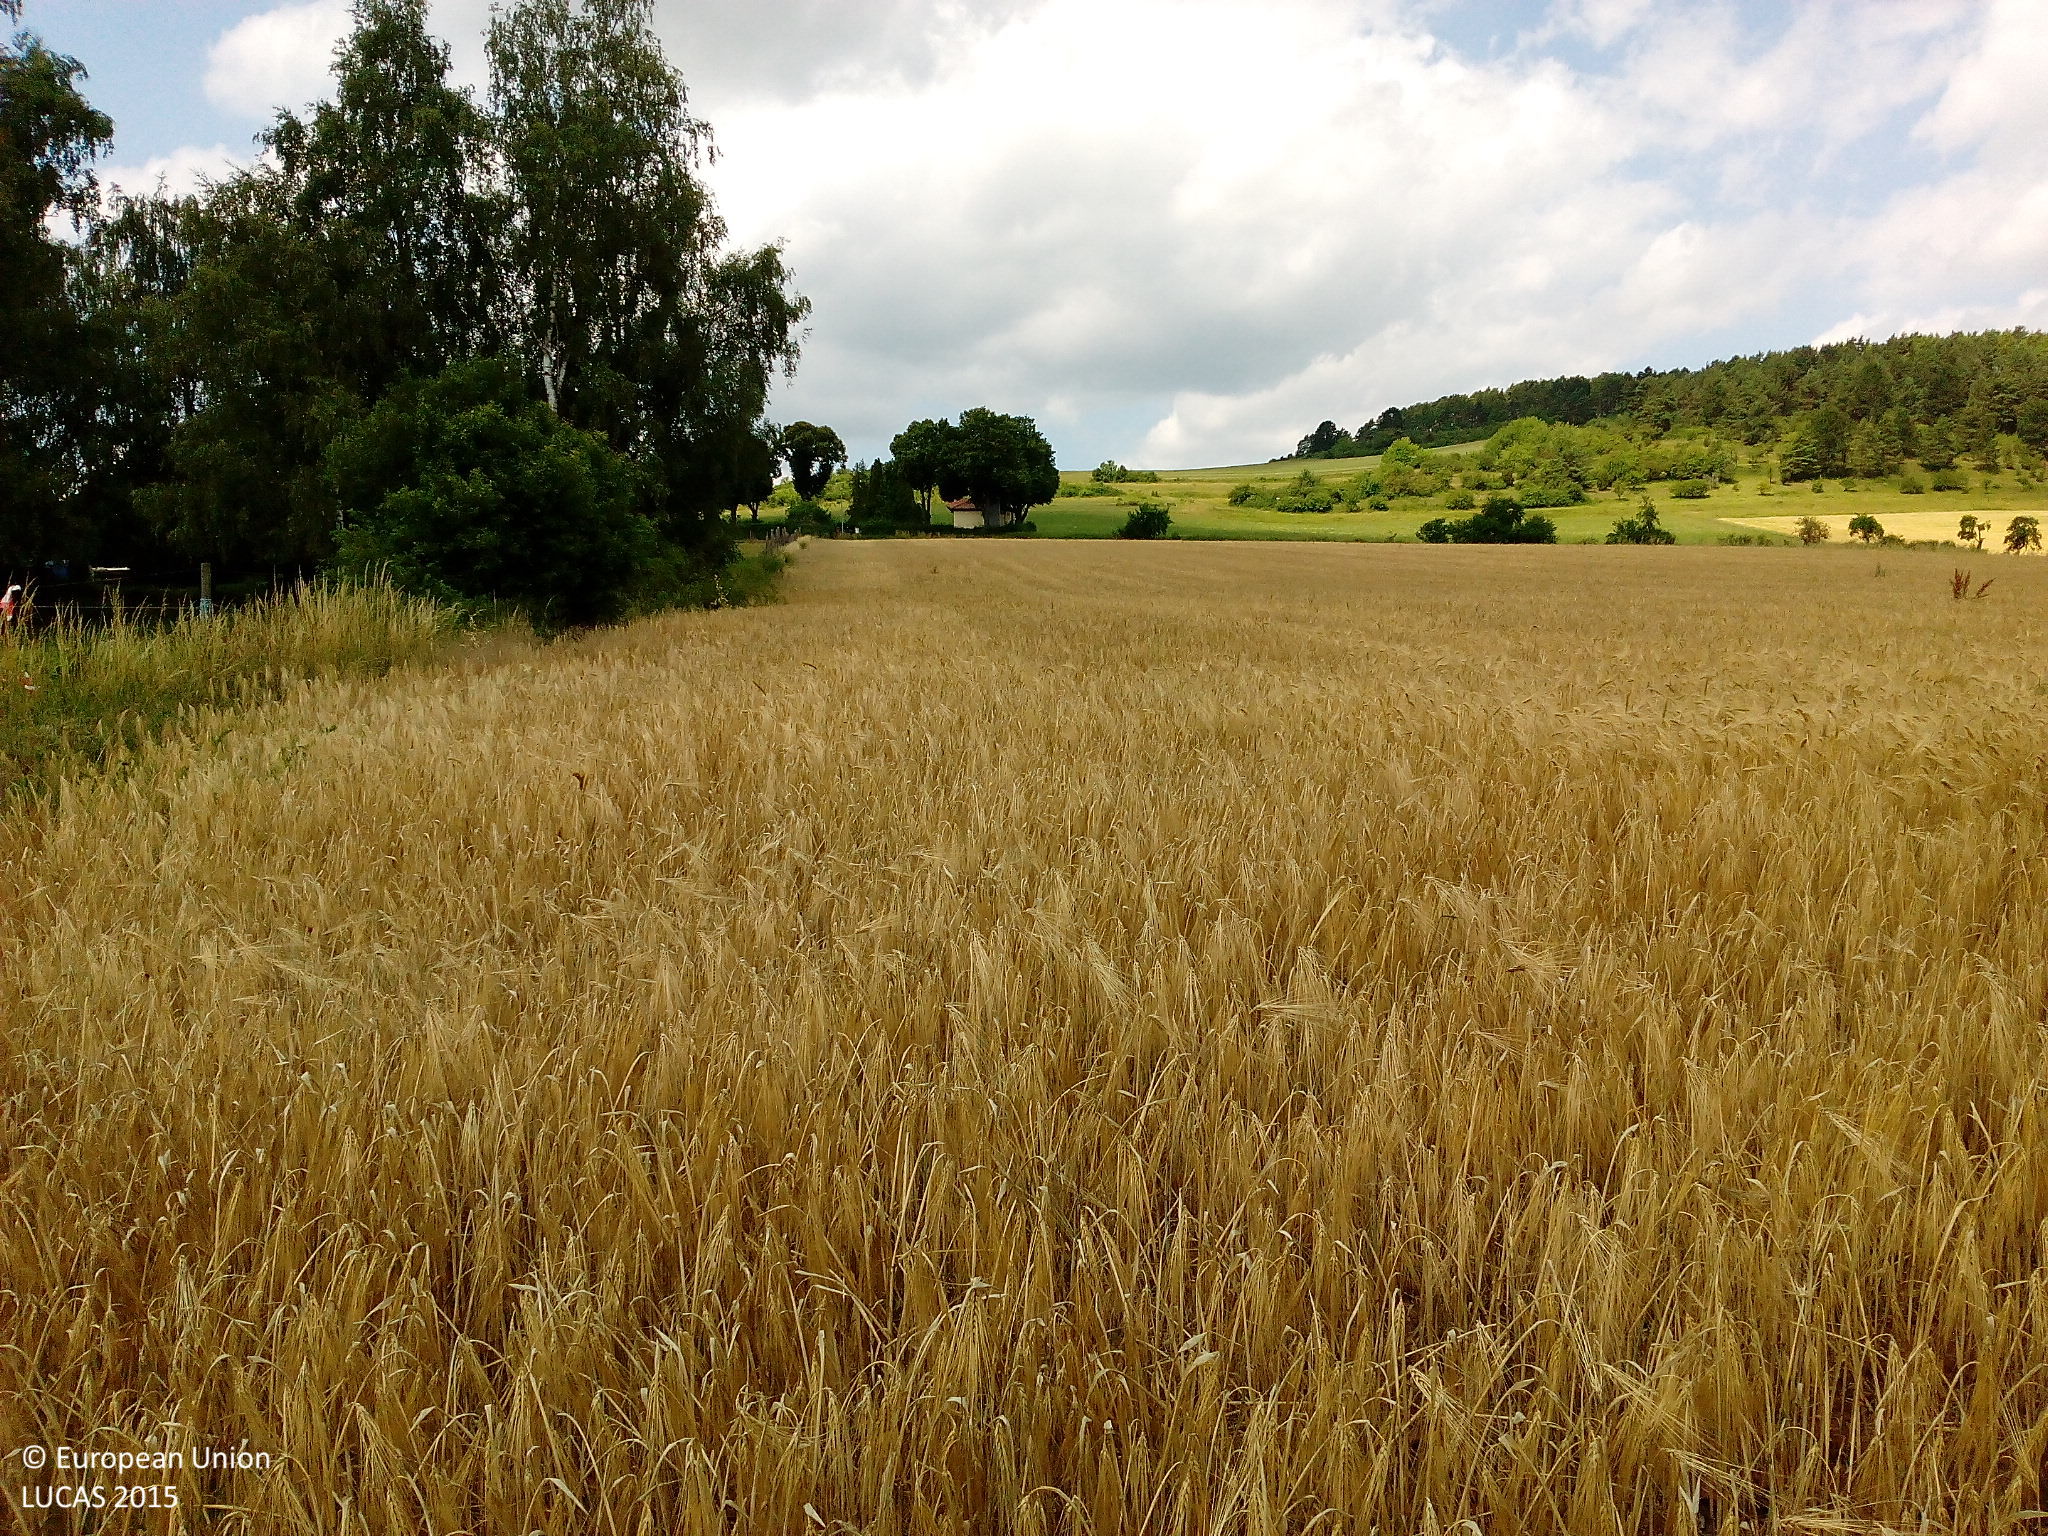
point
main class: Cropland
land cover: Barley
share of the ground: > 75 %
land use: Agriculture (excluding fallow land and kitchen gardens)
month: July
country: DE
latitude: 50.7056
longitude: 9.9292
